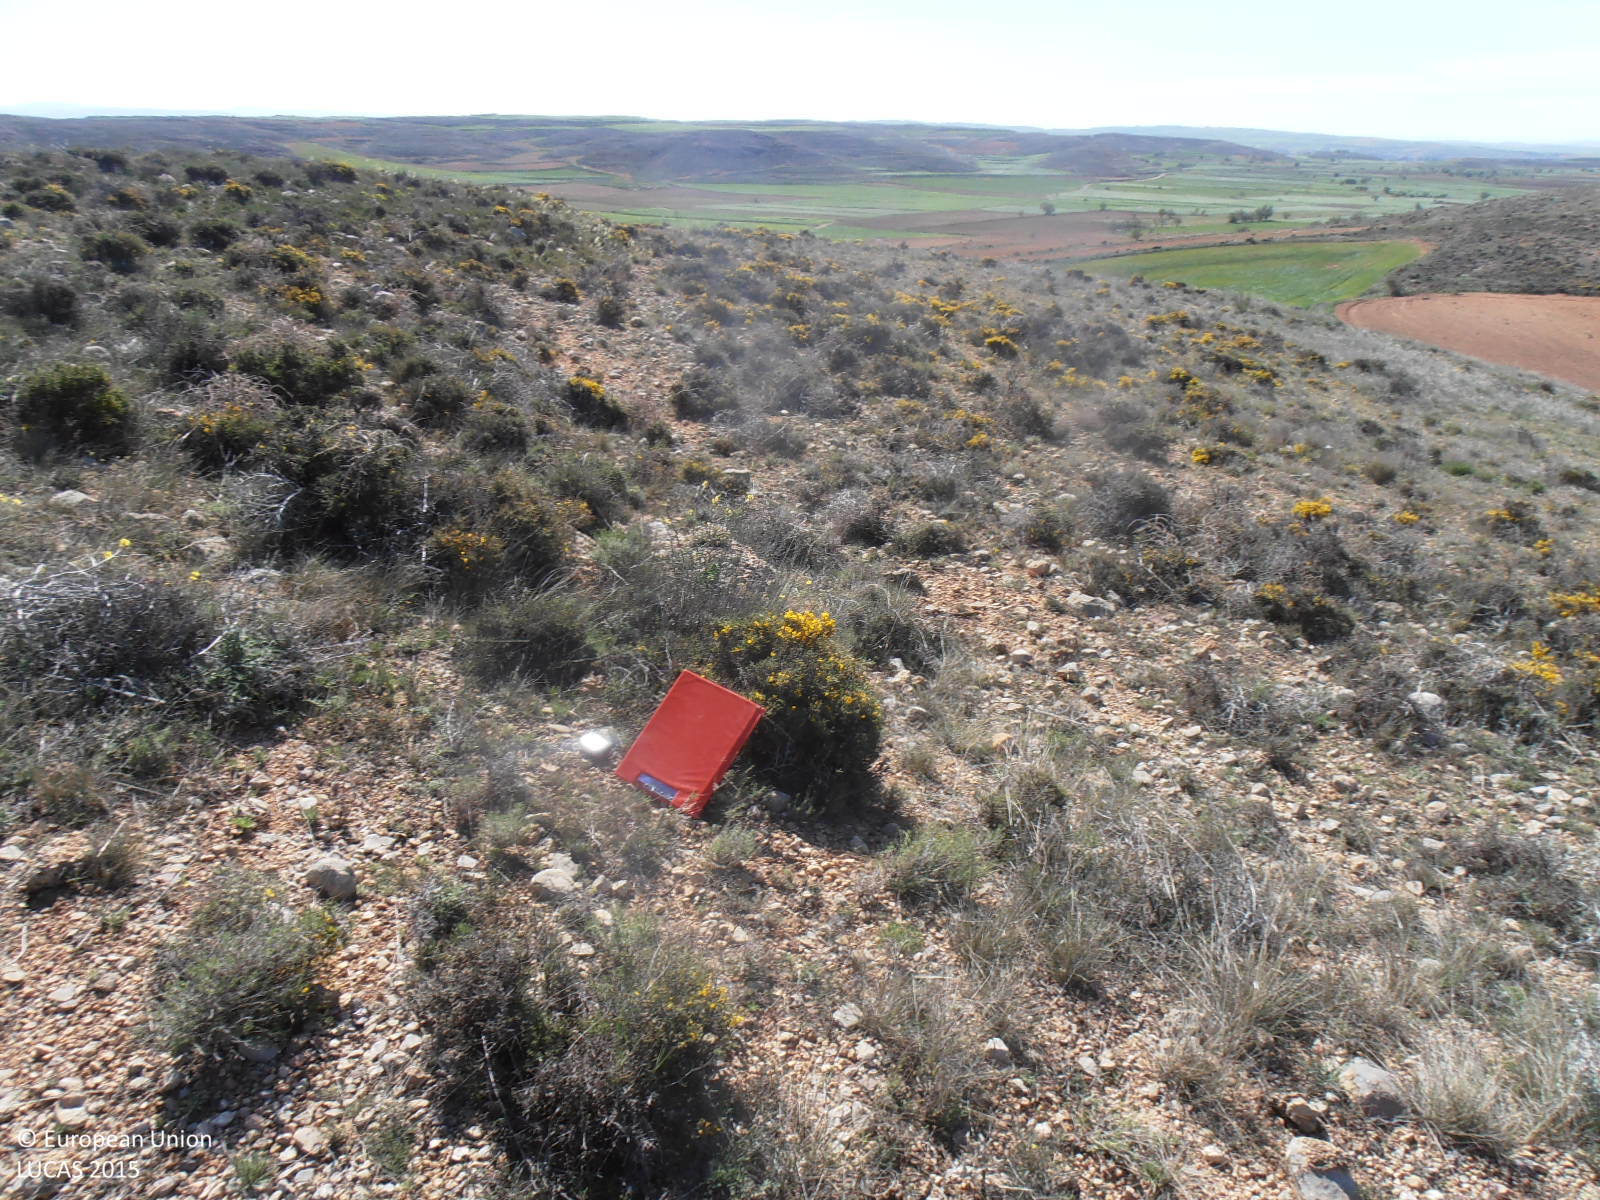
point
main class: Shrubland
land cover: Shrubland without tree cover
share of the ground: 50 - 75 %
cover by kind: consolidated bare surface 50 %, shrubs 40 %, herbaceous plants 10 %
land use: Semi-natural and natural areas not in use
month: April
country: ES
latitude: 41.1663
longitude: -0.9470
